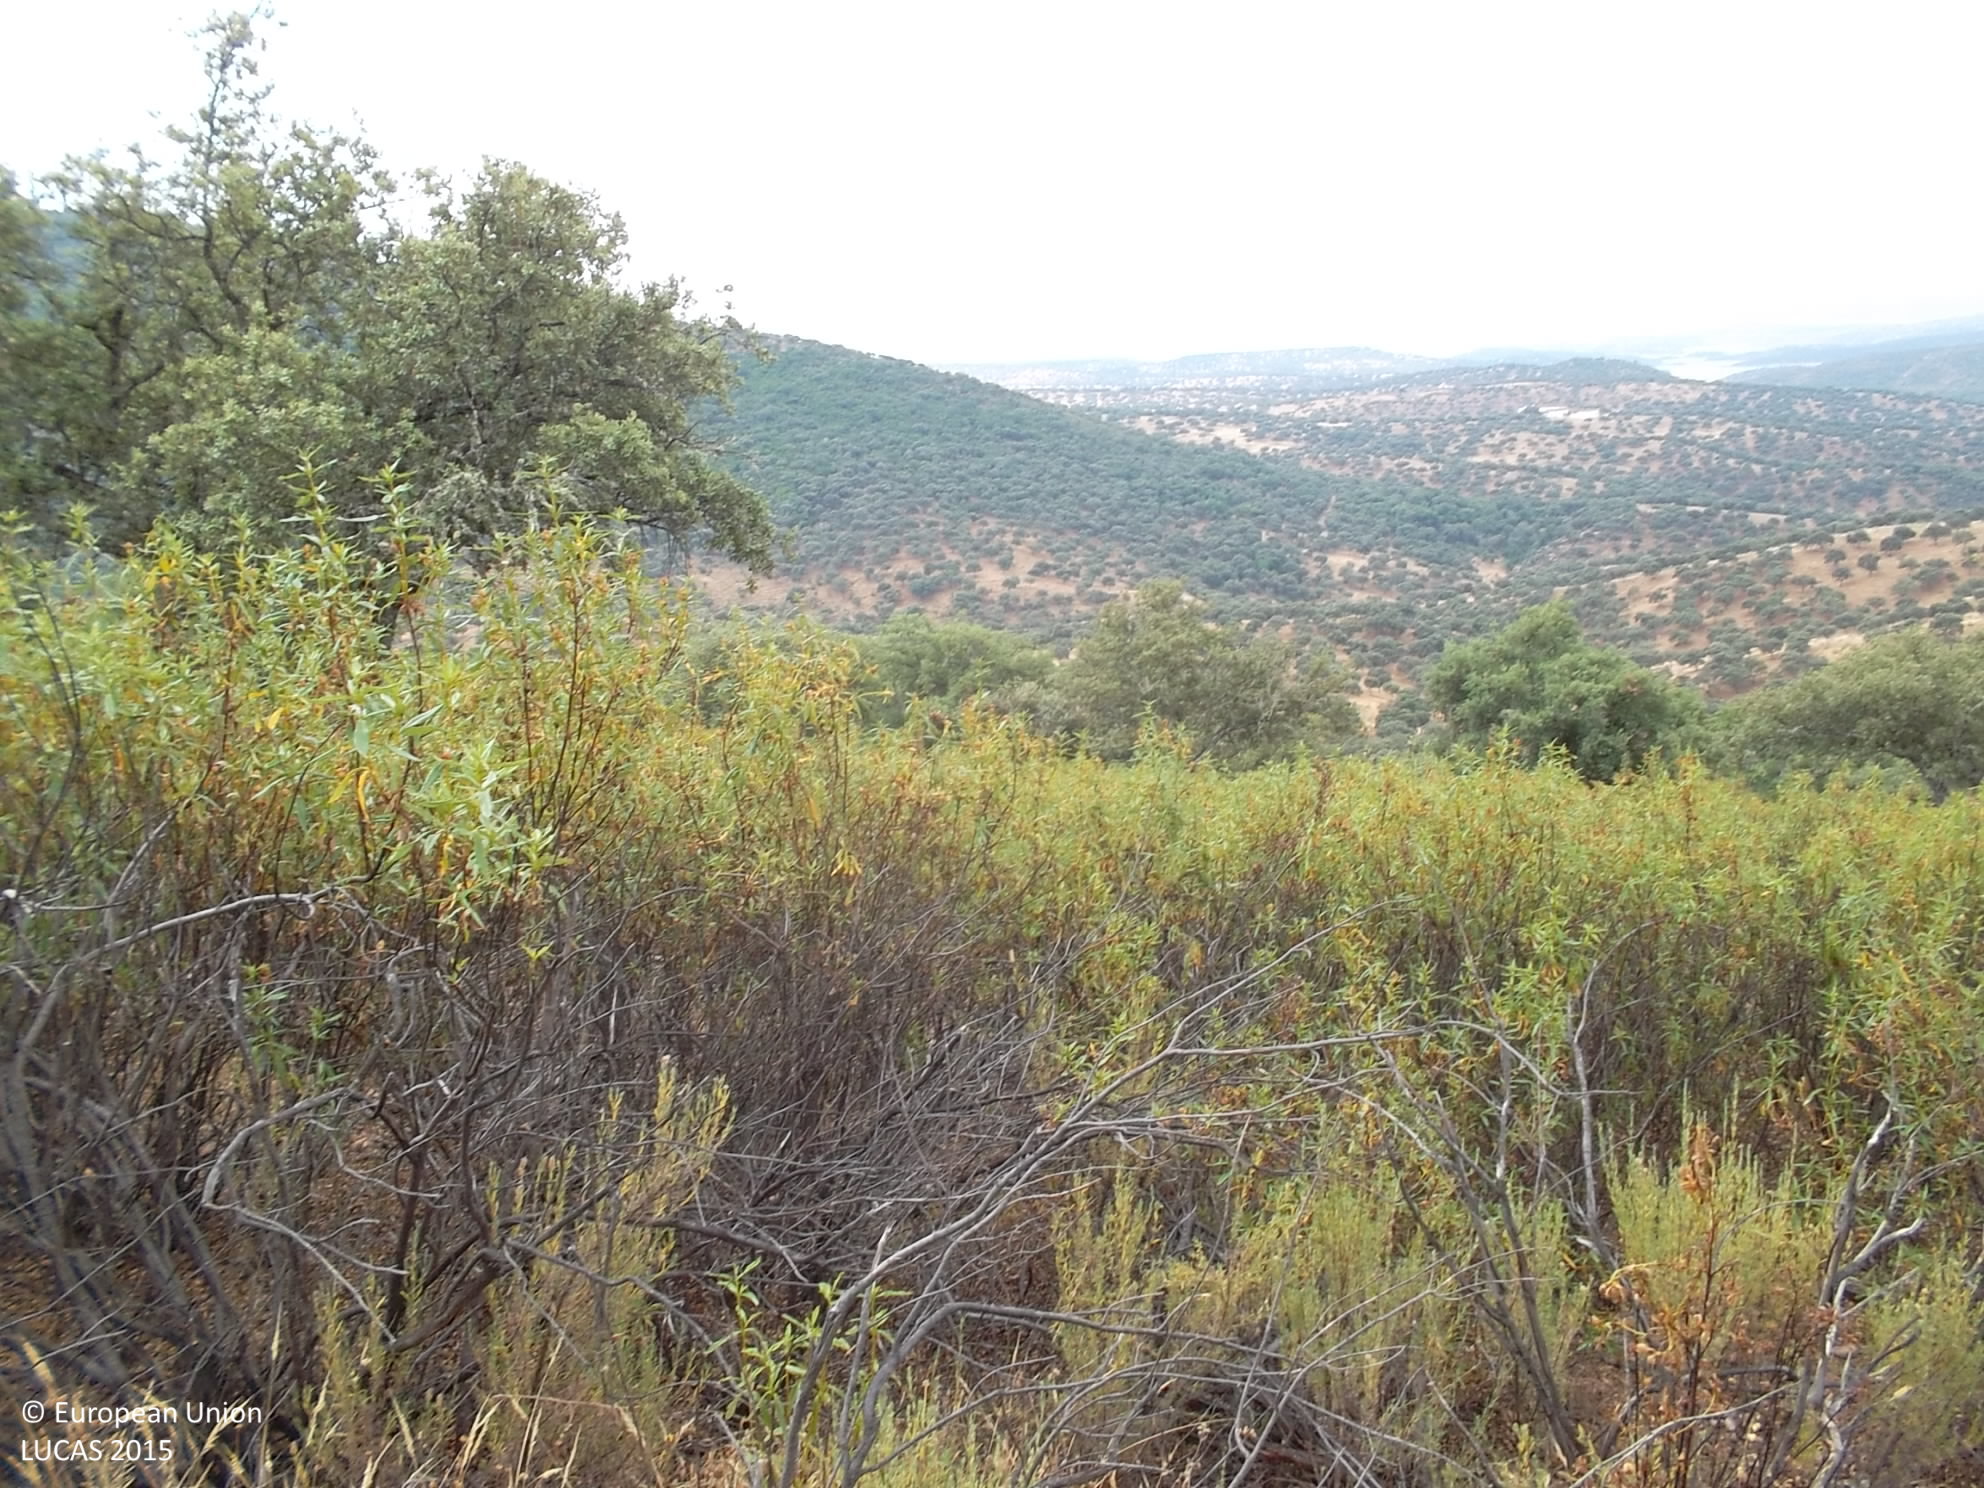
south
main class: Woodland
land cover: Broadleaved woodland
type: broadleaved evergreen forest
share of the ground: 50 - 75 %
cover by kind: shrubs 70 %, broadleaved forest trees 20 %, herbaceous plants 10 %
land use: Semi-natural and natural areas not in use
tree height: > 5 m
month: June
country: ES
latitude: 39.3459
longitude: -4.9979
